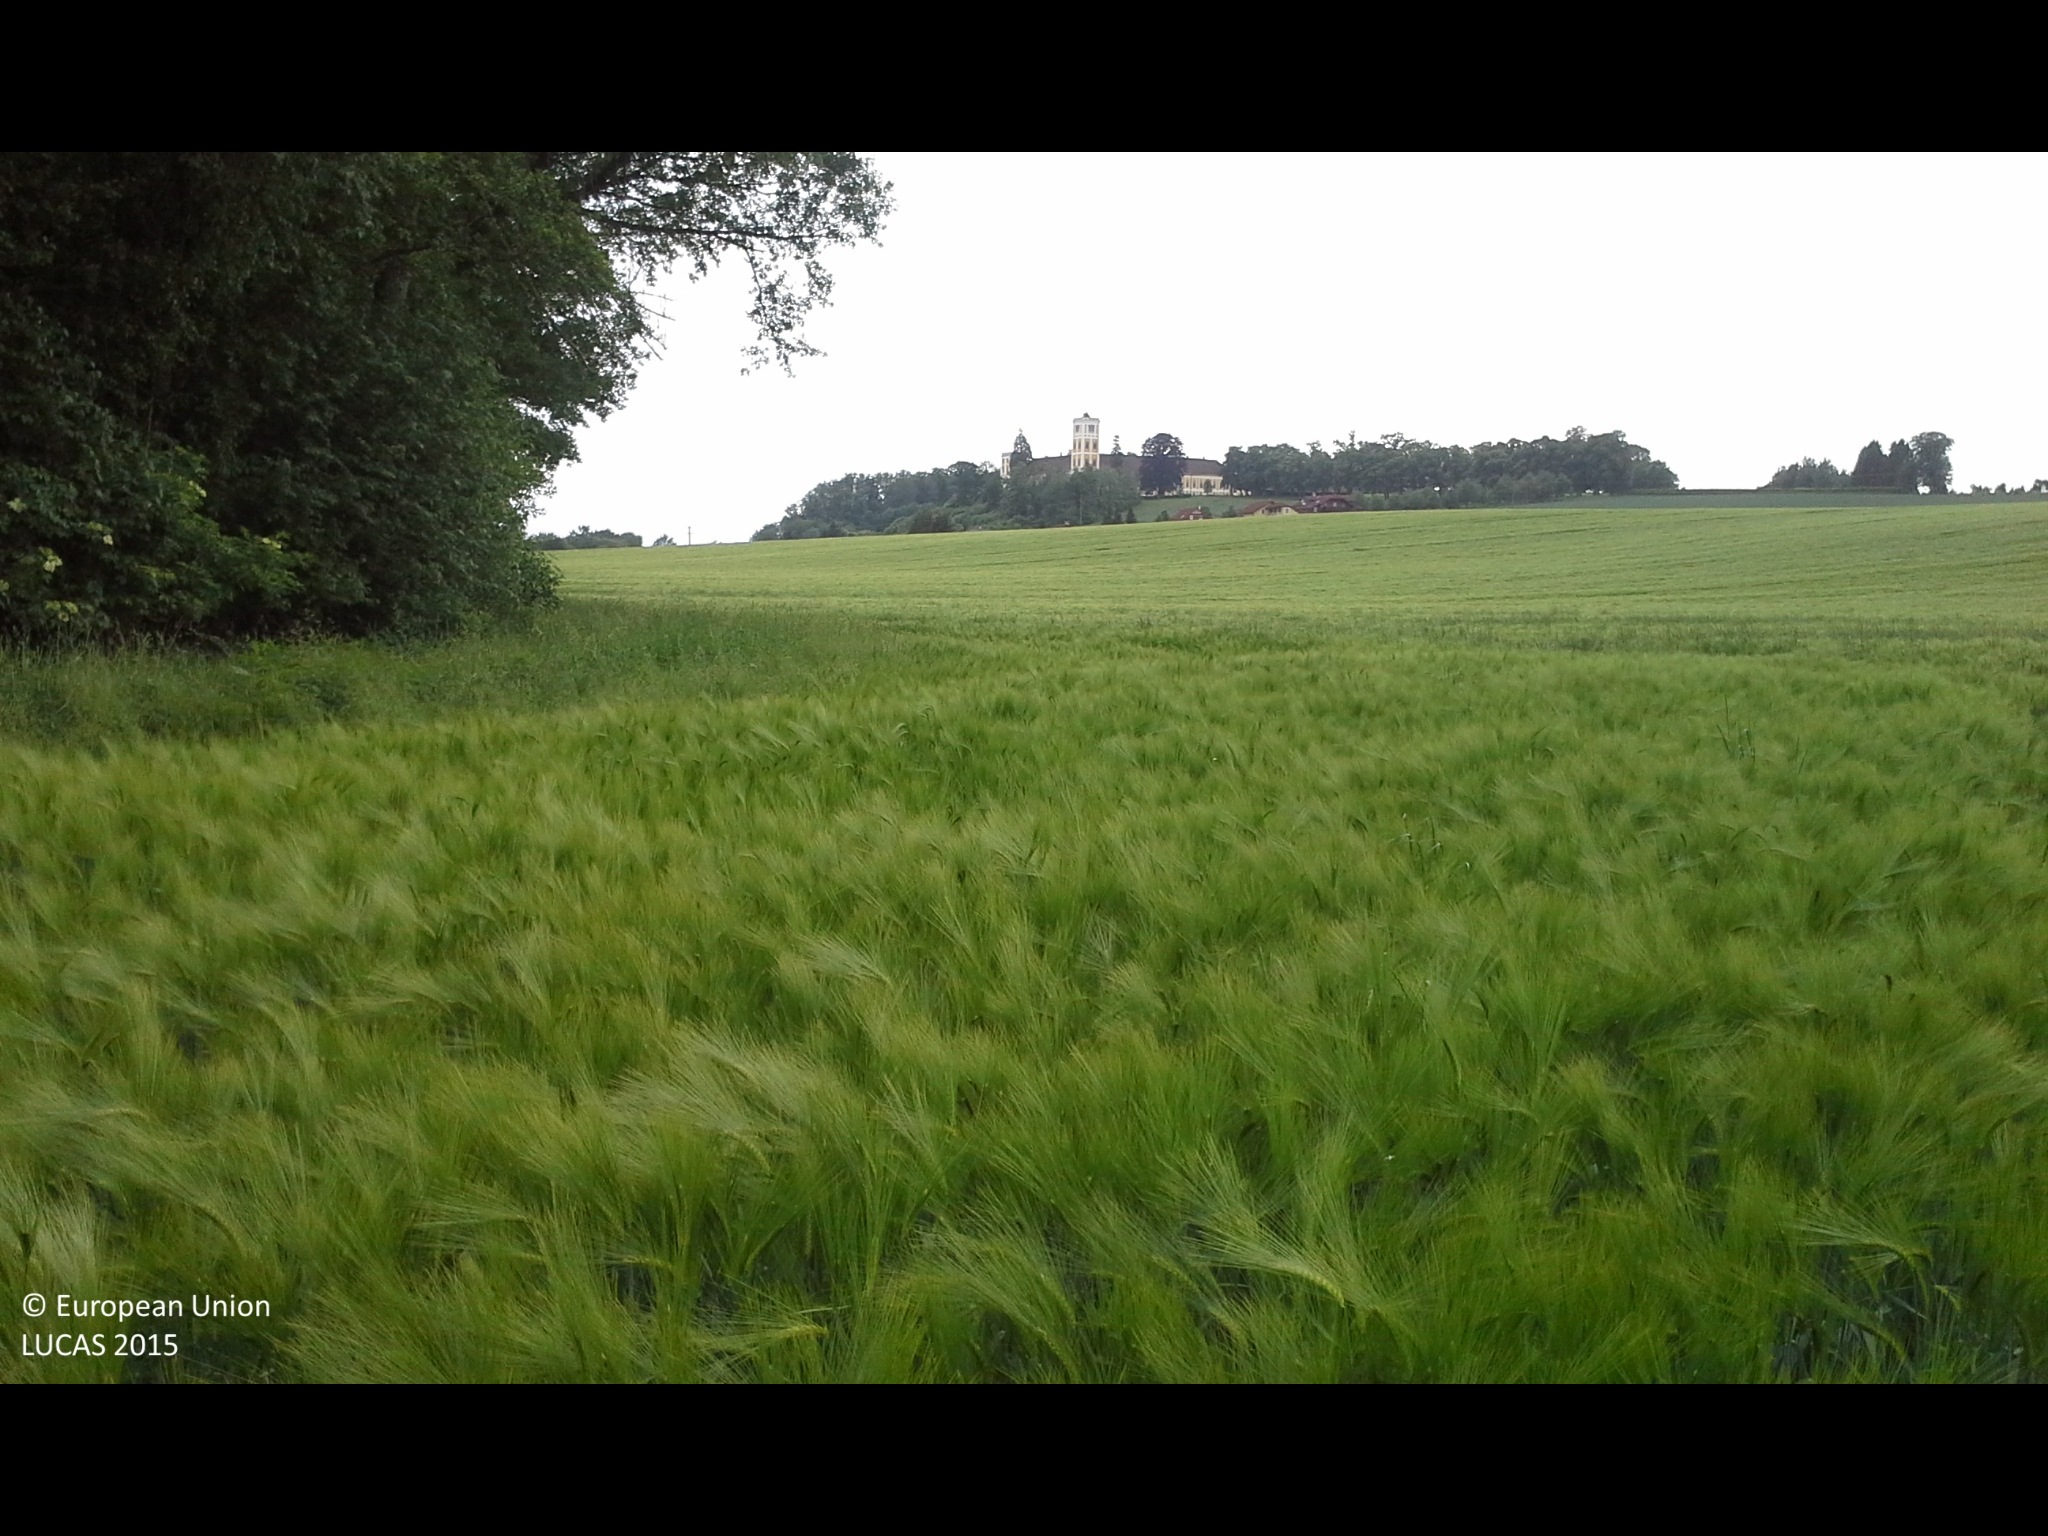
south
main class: Cropland
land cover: Barley
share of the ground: > 75 %
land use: Agriculture (excluding fallow land and kitchen gardens)
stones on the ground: < 10 %
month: May
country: AT
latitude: 48.2067
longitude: 14.4273
